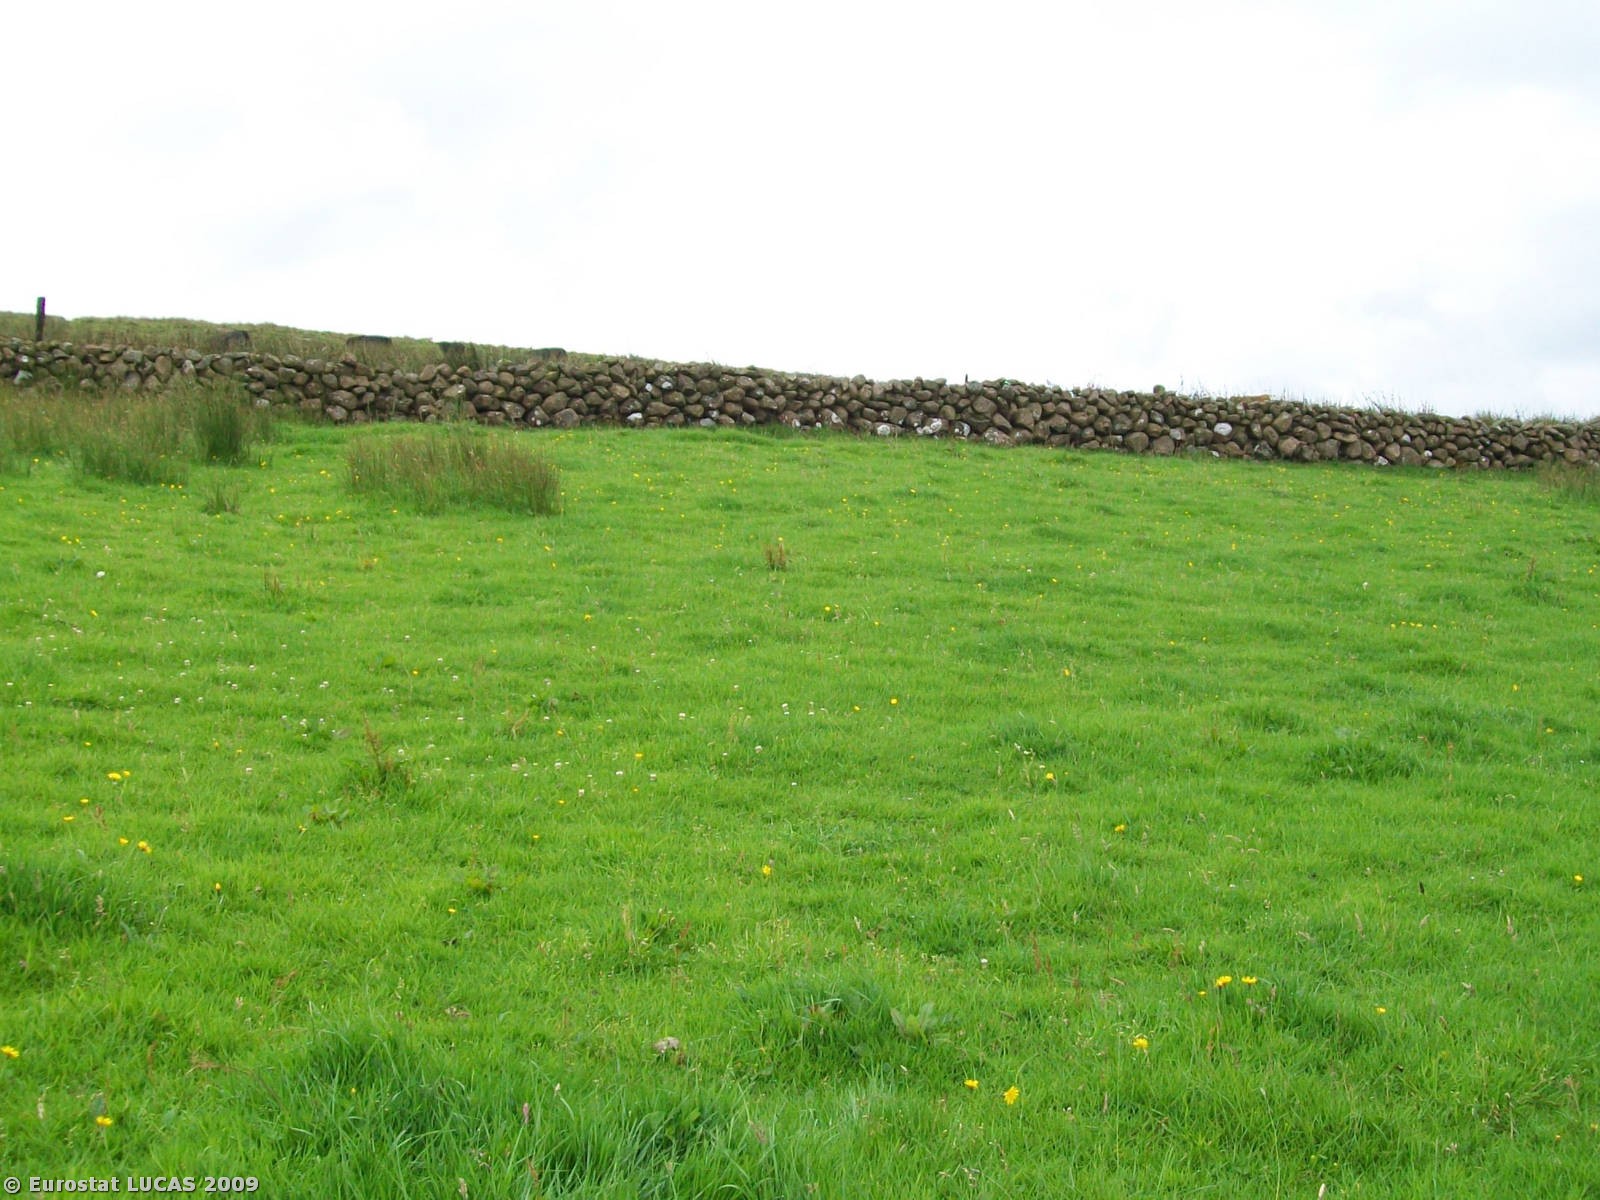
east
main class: Grassland
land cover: Grassland without tree/shrub cover
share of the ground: > 75 %
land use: Agriculture (excluding fallow land and kitchen gardens)
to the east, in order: Grassland without tree/shrub cover; Dry stone walls; Fences; Grassland without tree/shrub cover; Dry stone walls; Grassland without tree/shrub cover
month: July
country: GB
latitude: 54.8343
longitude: -6.0688
